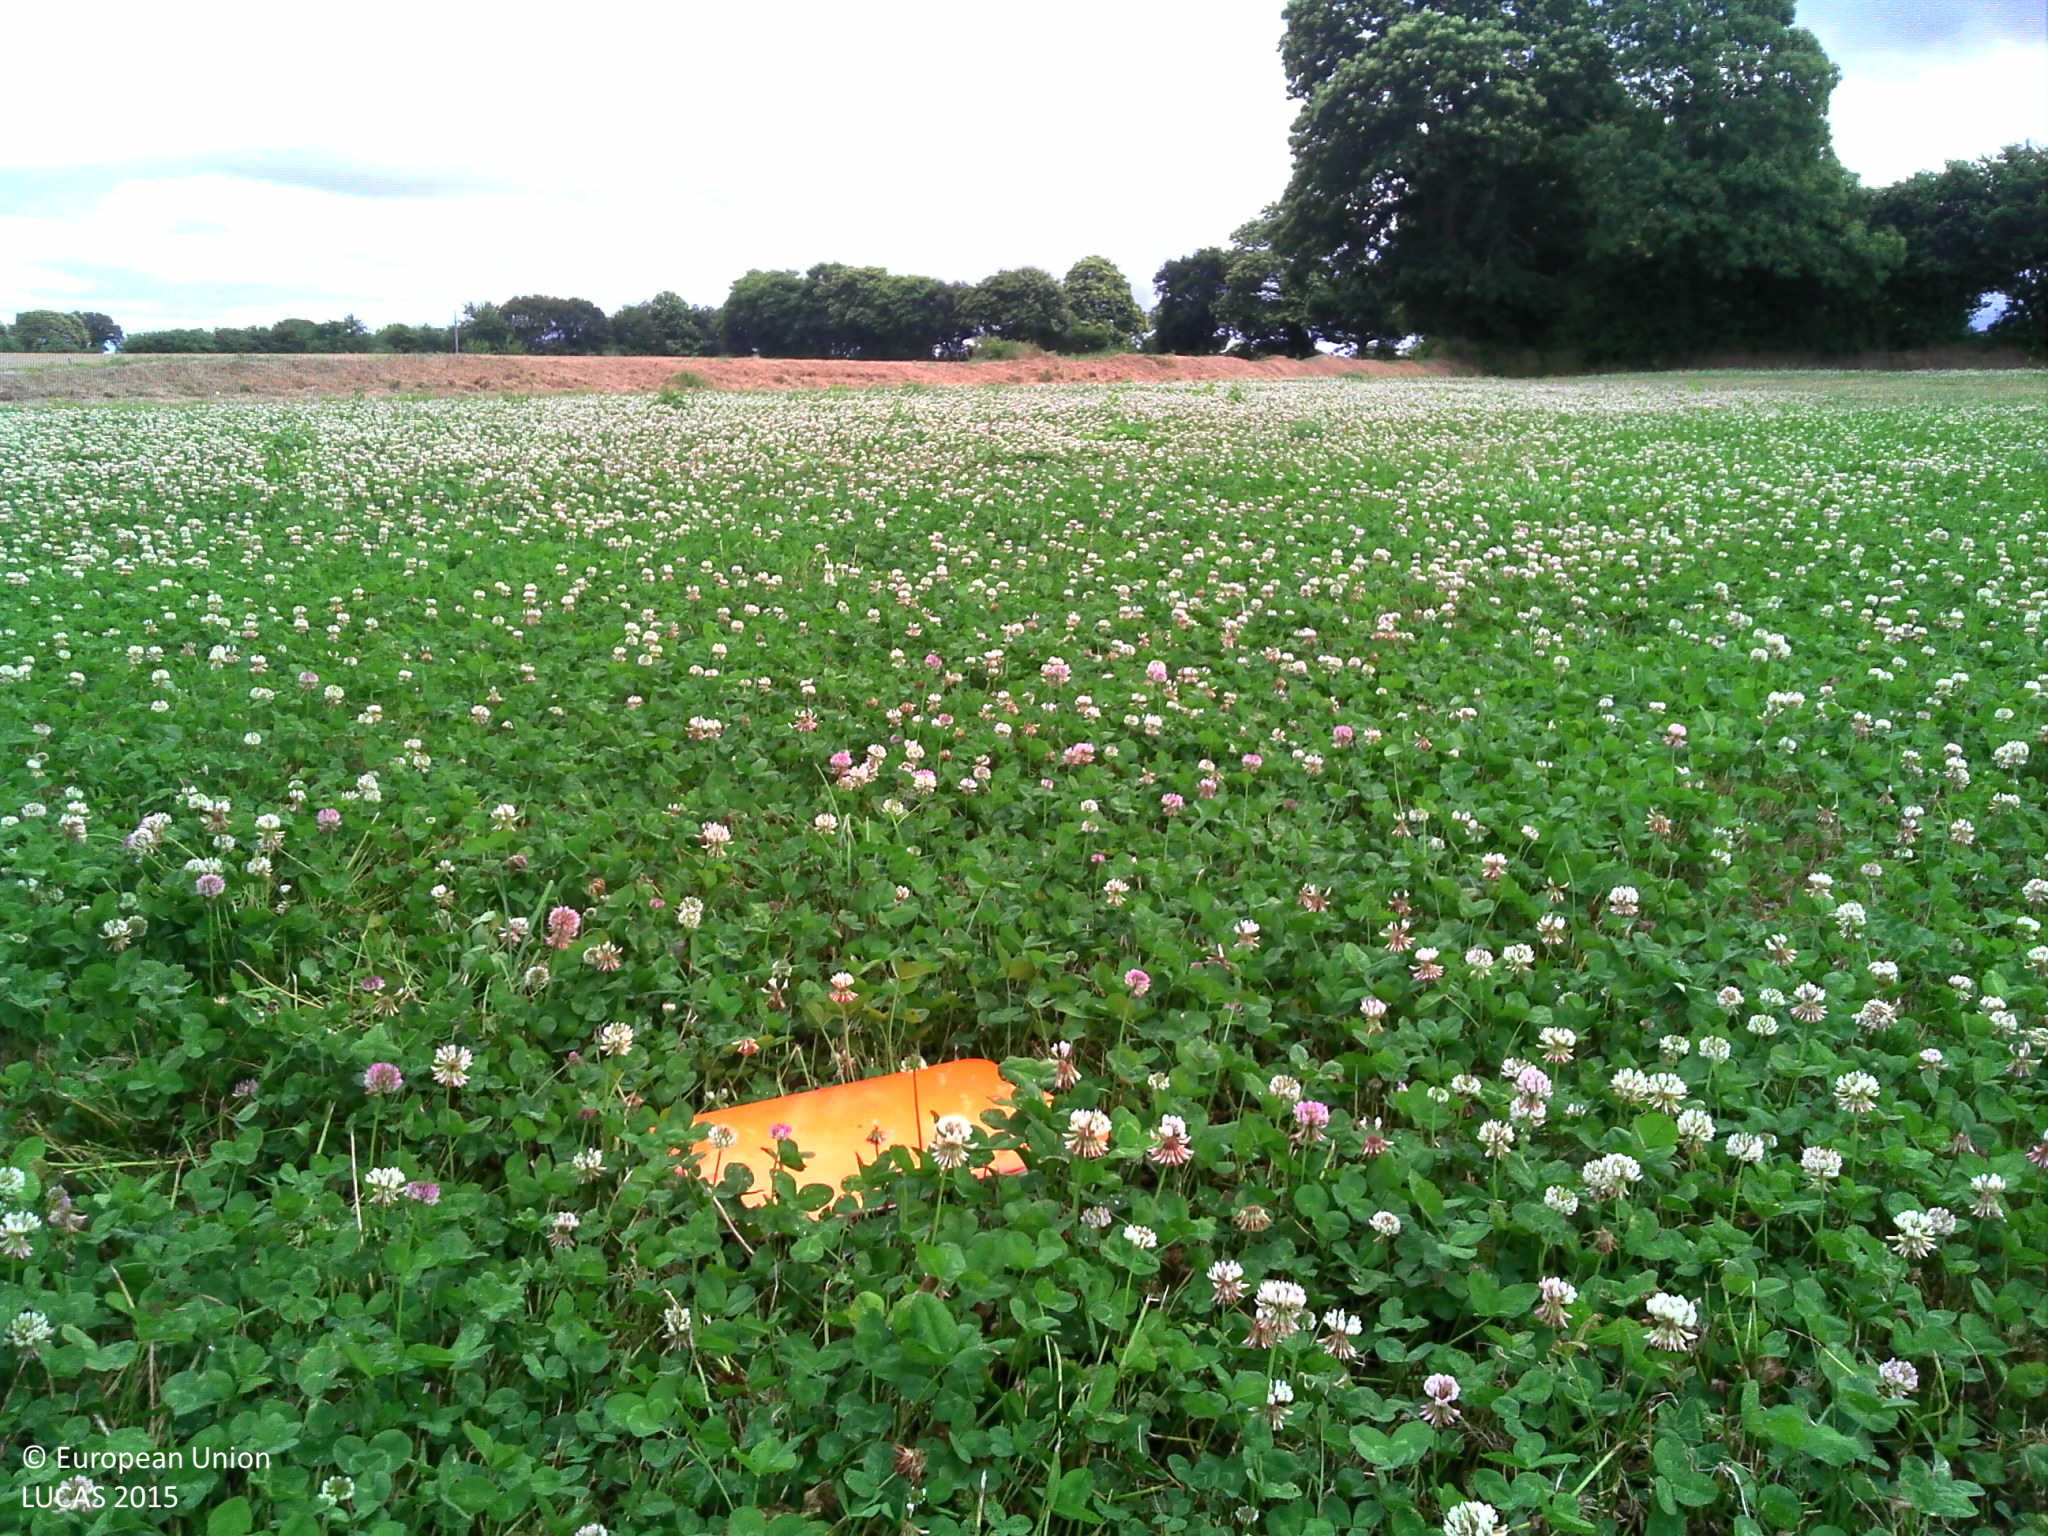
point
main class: Cropland
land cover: Clovers
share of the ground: > 75 %
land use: Agriculture (excluding fallow land and kitchen gardens)
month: July
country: FR
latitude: 48.6532
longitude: -3.4497
